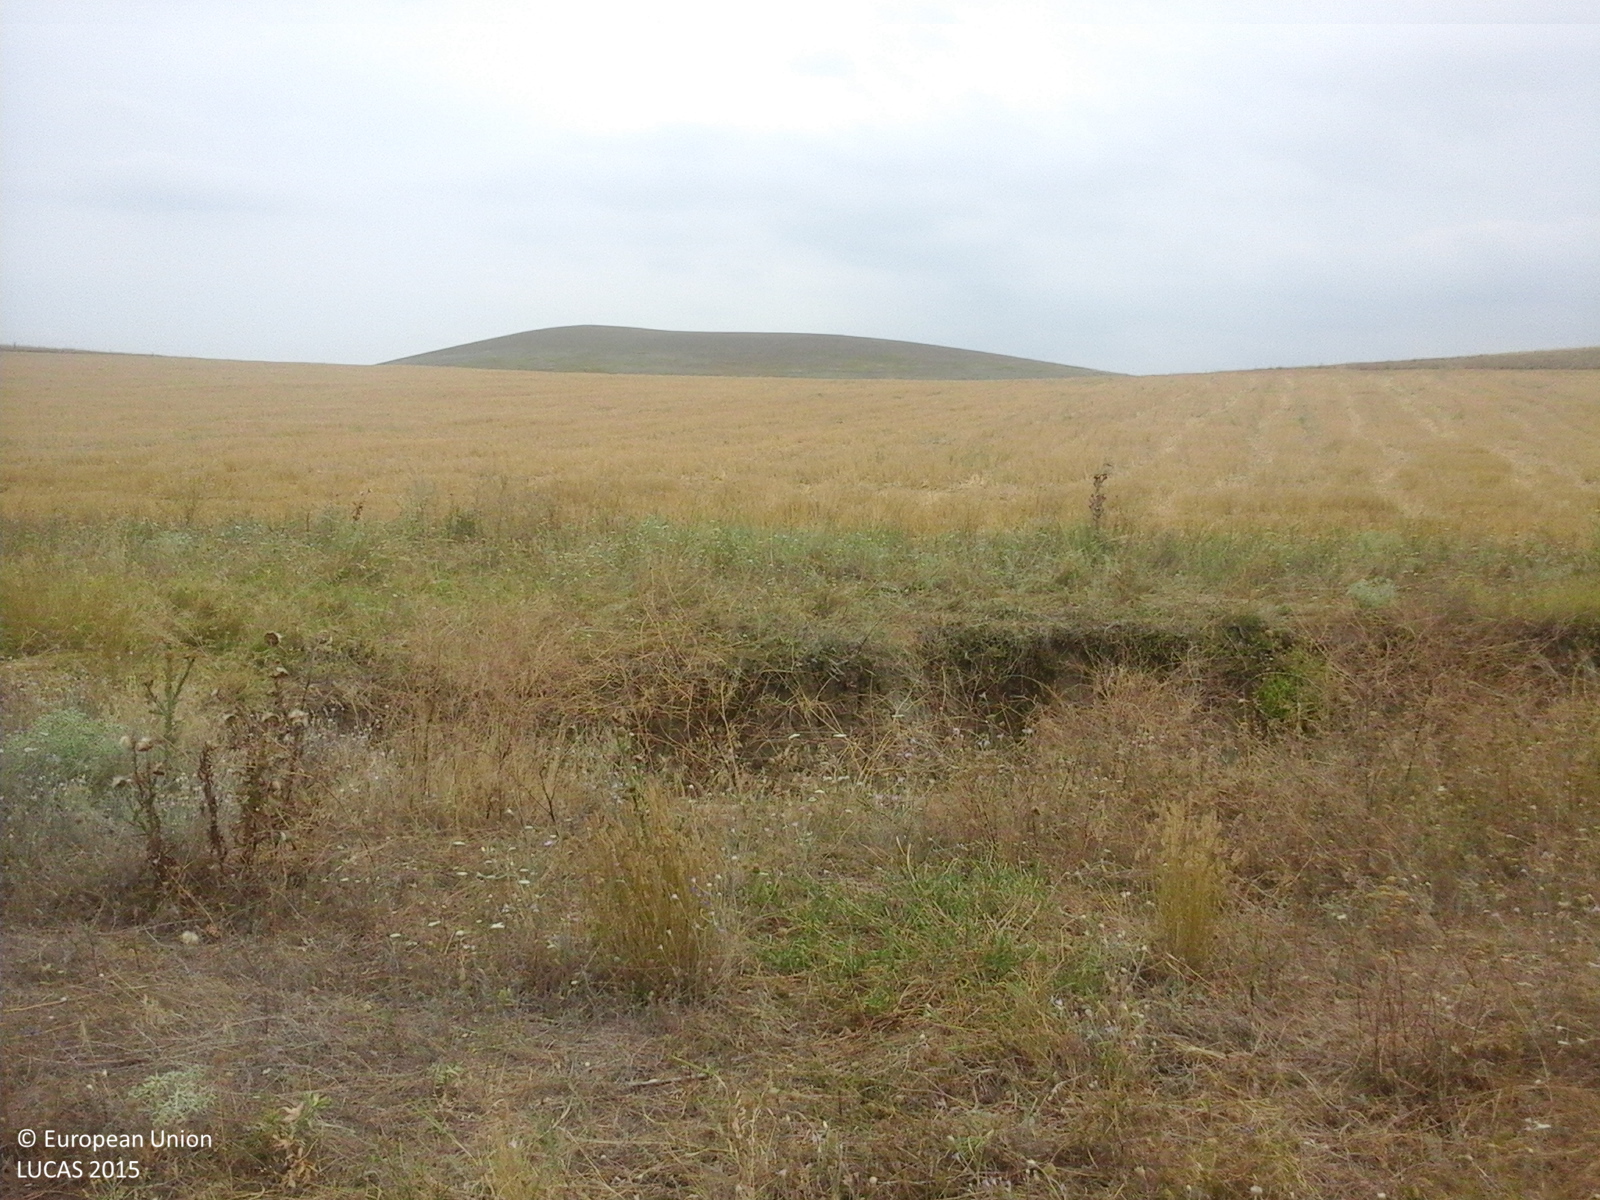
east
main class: Grassland
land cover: Grassland without tree/shrub cover
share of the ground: > 75 %
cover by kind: herbaceous plants 100 %
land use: Agriculture (excluding fallow land and kitchen gardens)
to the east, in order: Grassland without tree/shrub cover; Spontaneously vegetated surfaces; Common wheat; Grassland without tree/shrub cover; Sunflower
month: July
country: RO
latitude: 45.0558
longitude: 28.2676
